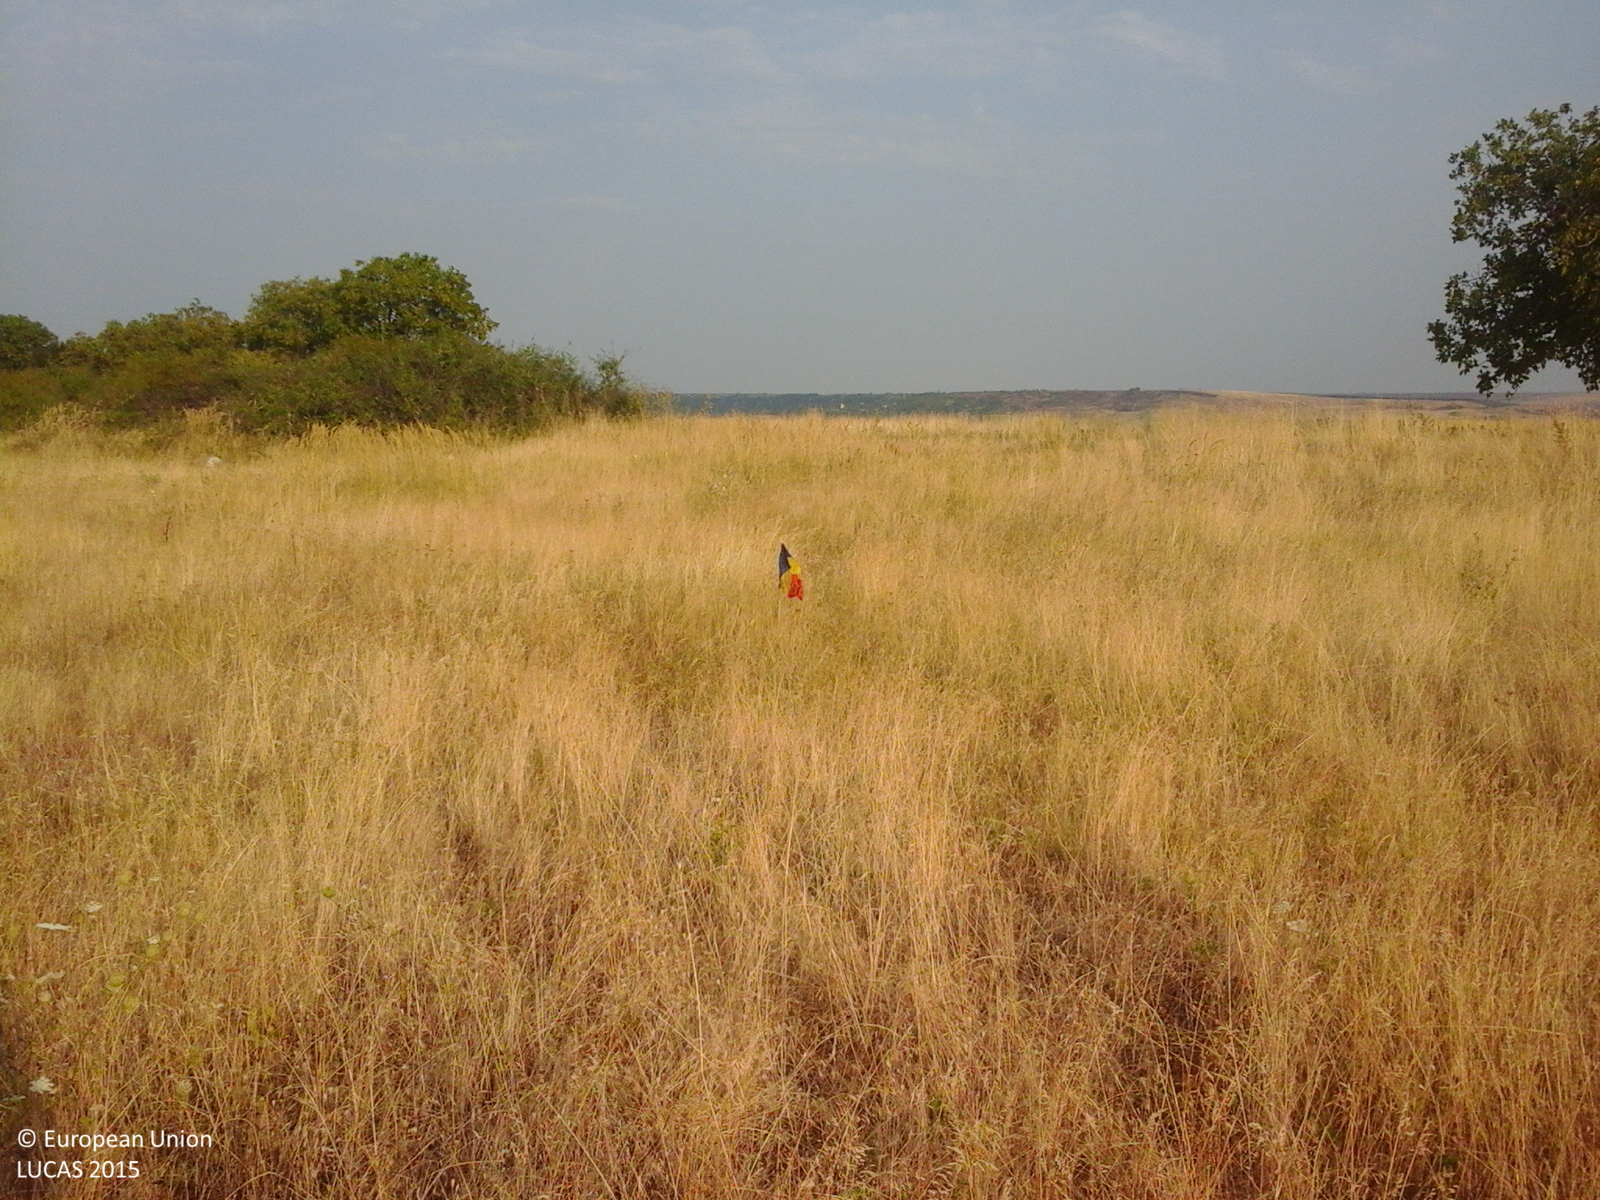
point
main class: Grassland
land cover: Grassland without tree/shrub cover
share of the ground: > 75 %
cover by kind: herbaceous plants 100 %
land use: Agriculture (excluding fallow land and kitchen gardens)
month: August
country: RO
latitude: 44.4414
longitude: 22.9989
